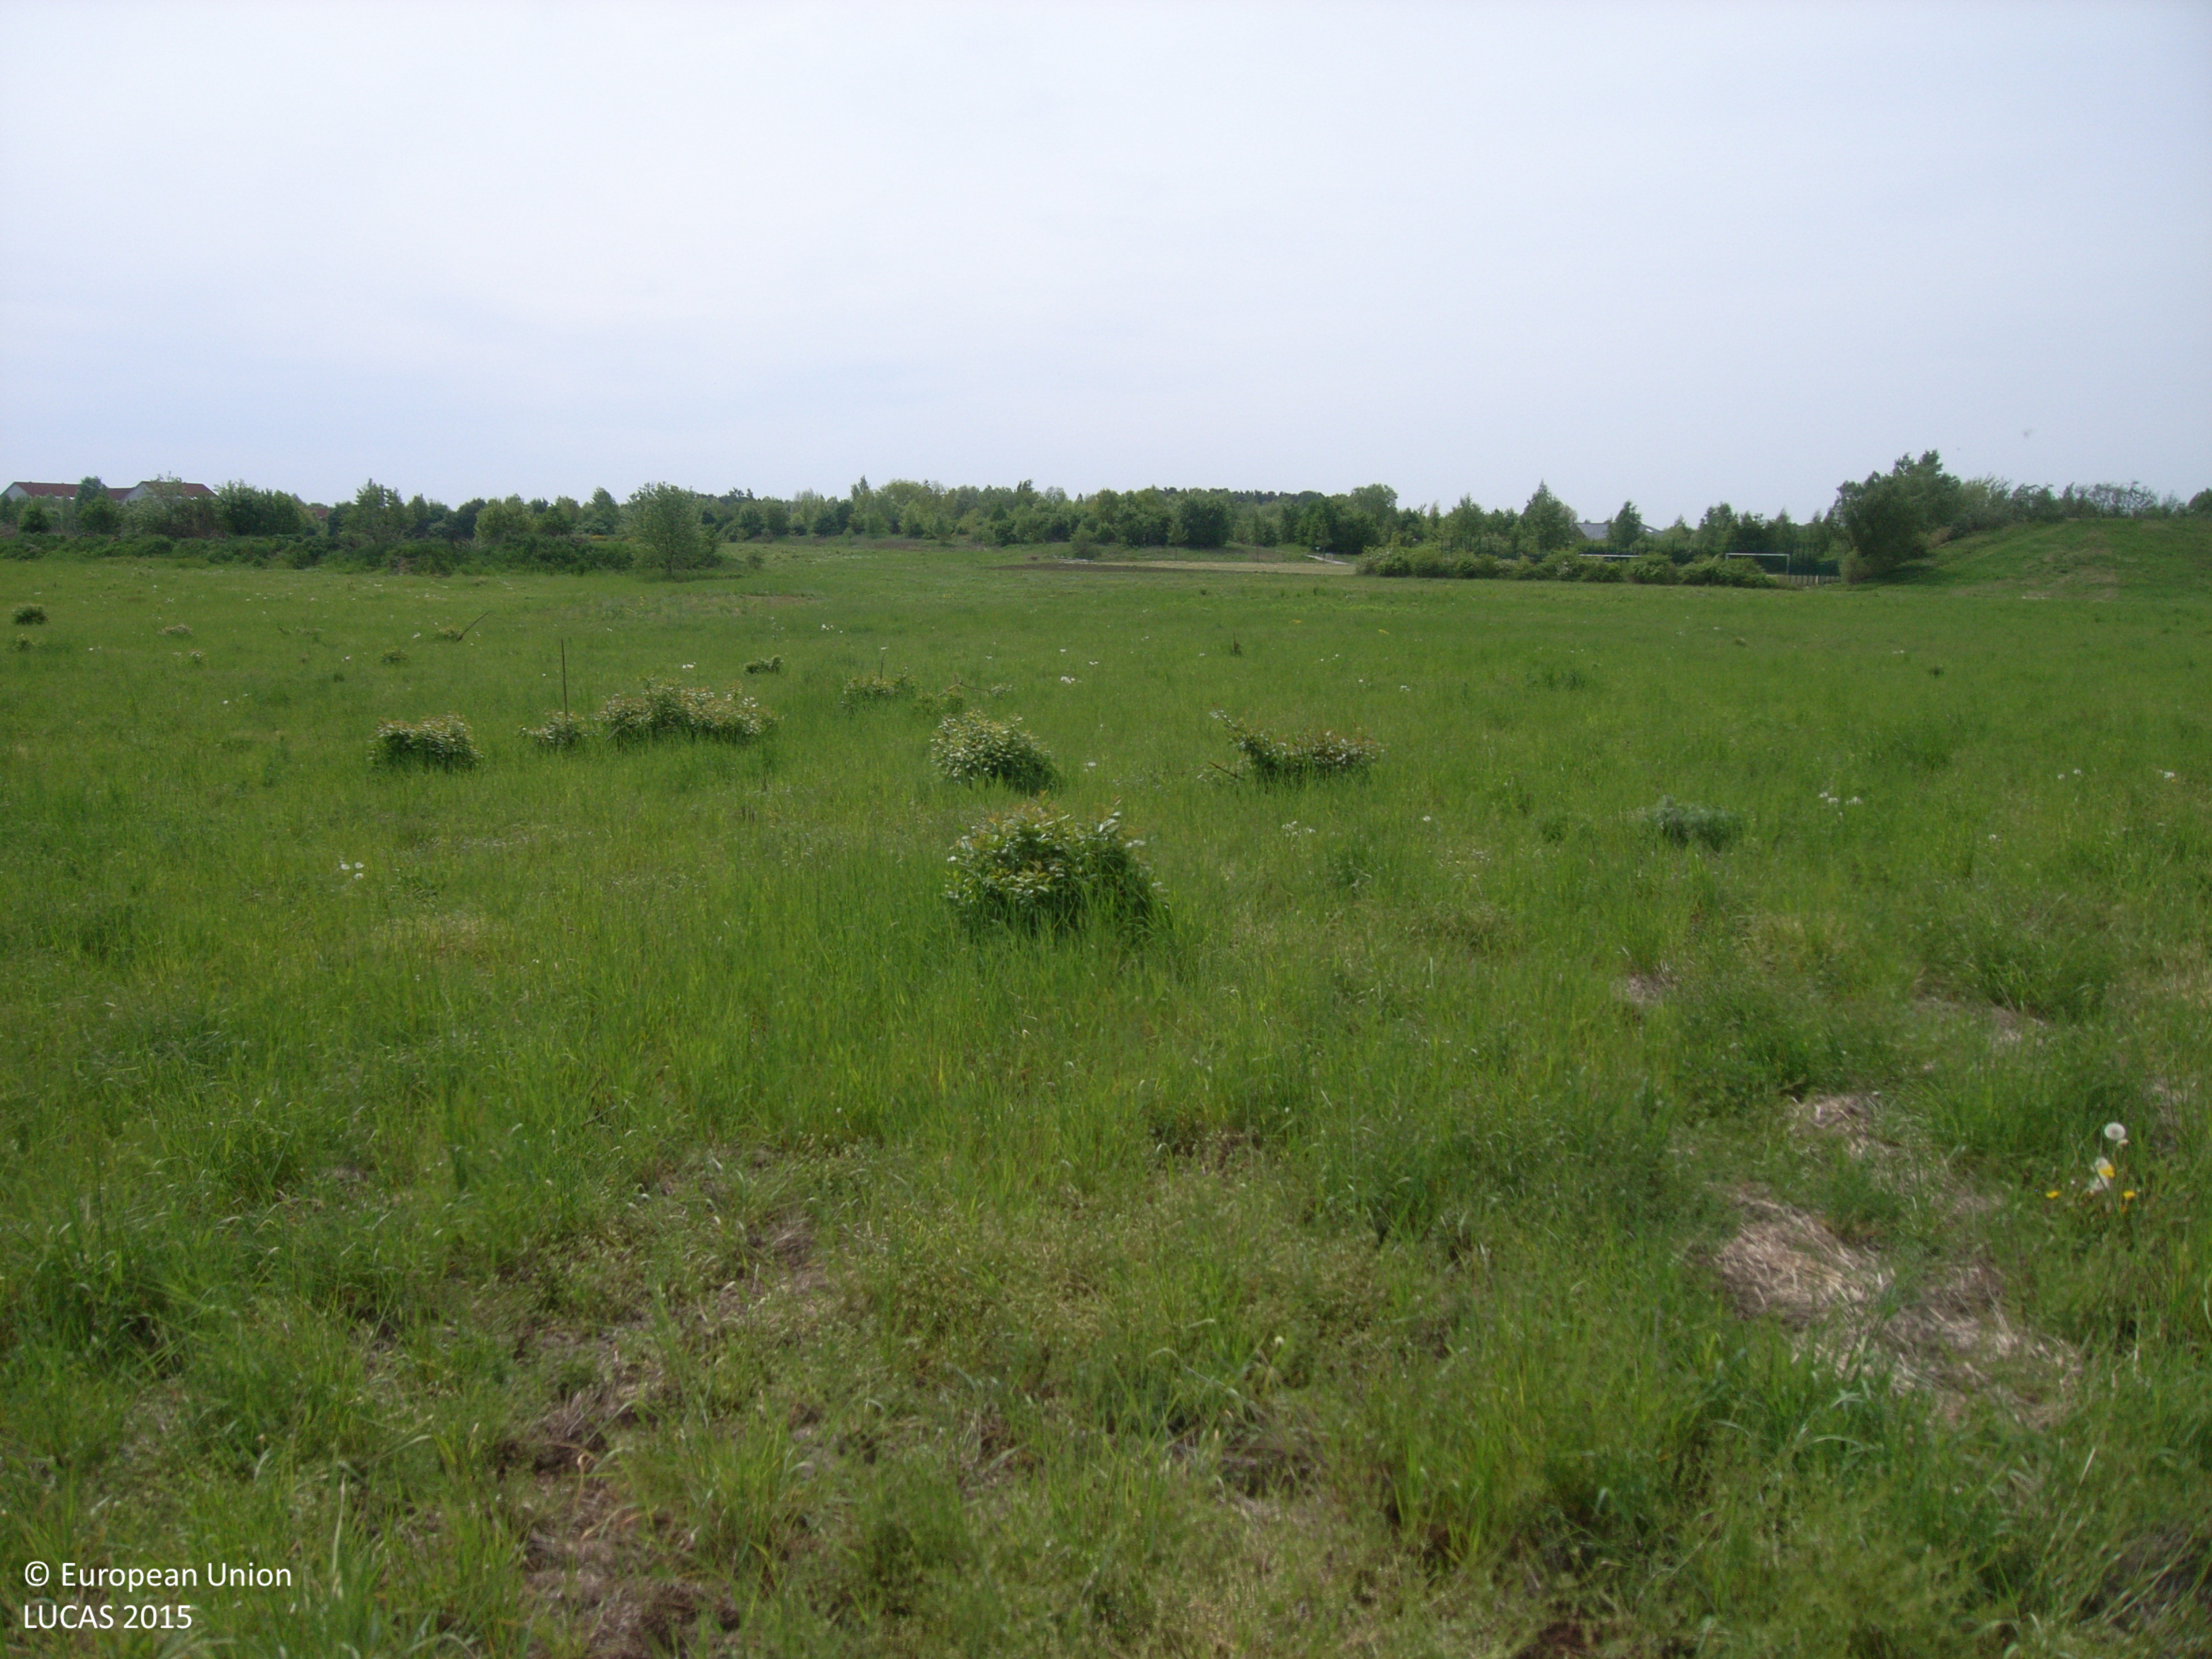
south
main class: Grassland
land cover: Grassland with sparse tree/shrub cover
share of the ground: > 75 %
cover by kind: herbaceous plants 95 %, broadleaved forest trees 5 %
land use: Abandoned areas
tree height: < 5 m
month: May
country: DE
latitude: 52.3051
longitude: 13.5935
